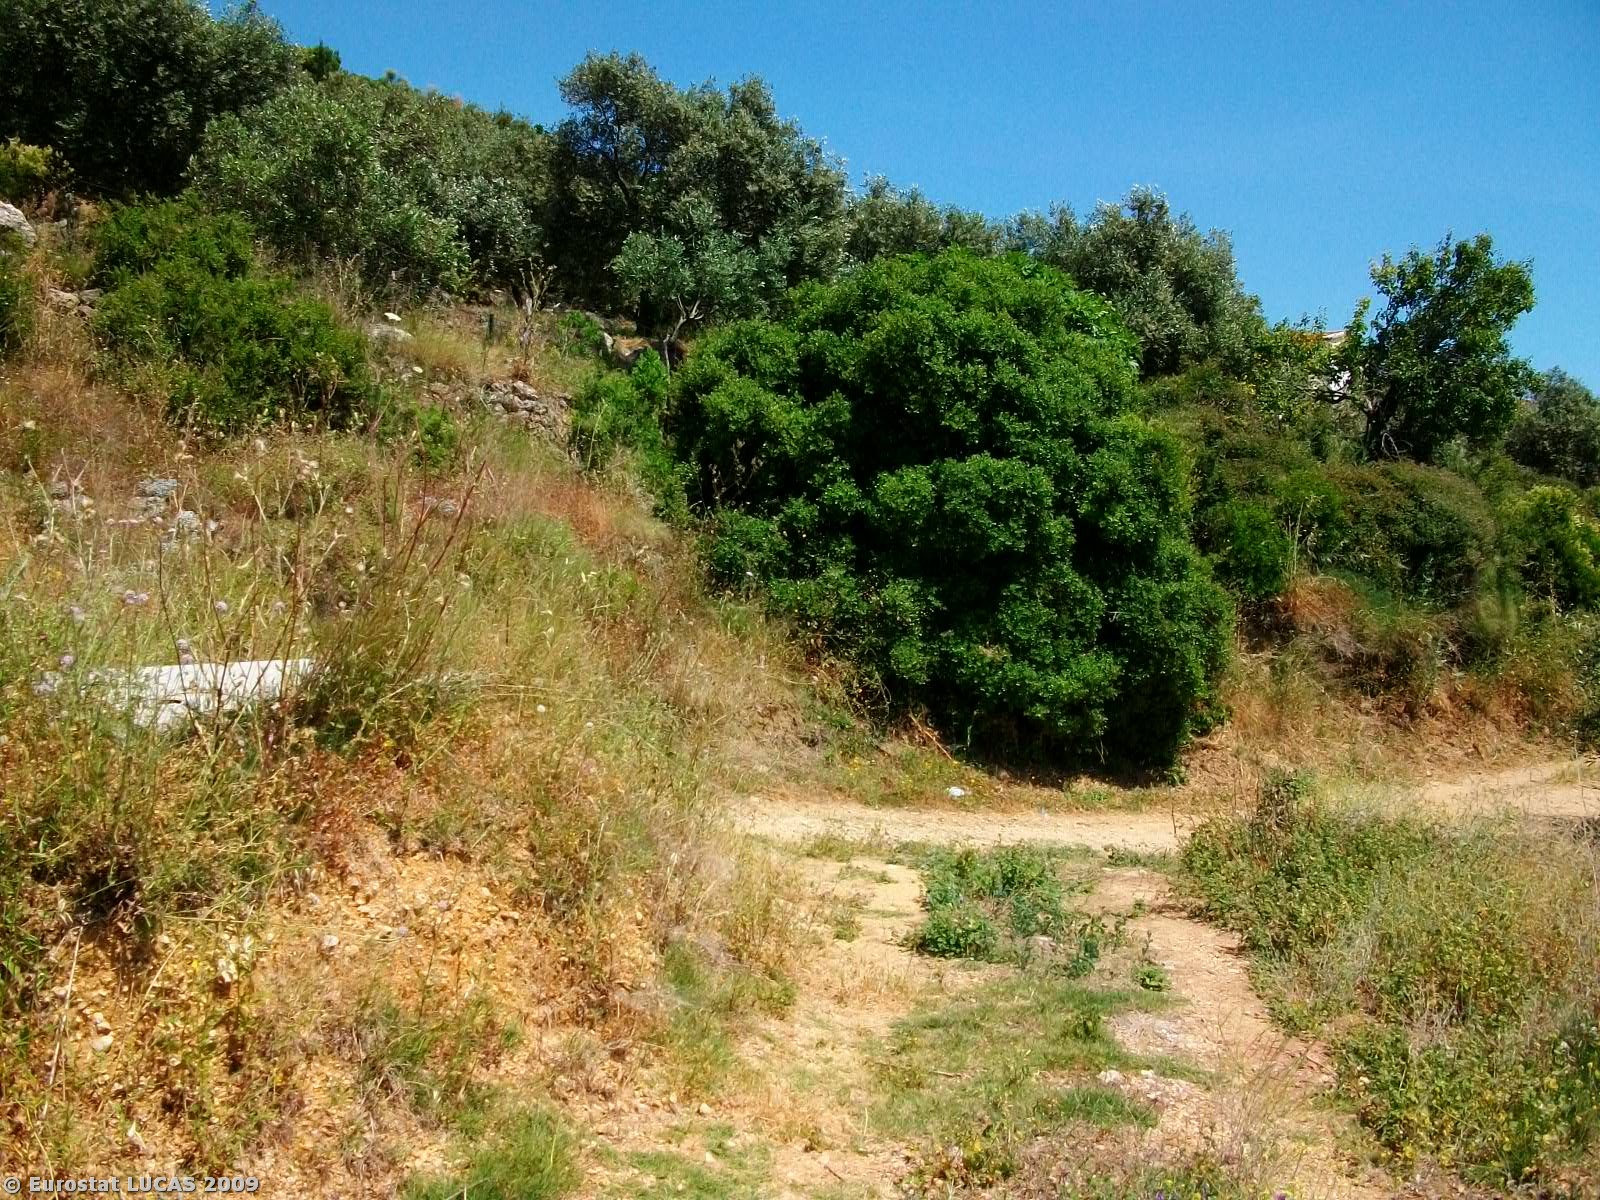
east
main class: Grassland
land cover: Grassland with sparse tree/shrub cover
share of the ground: > 75 %
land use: Unused
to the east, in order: Grassland with sparse tree/shrub cover; Paved roads, cycling and walking lanes; Olive groves; Bare land; Shrubland with sparse tree cover; Tracks; Shrubland with sparse tree cover
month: June
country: GR
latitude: 39.3169
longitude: 20.3531
